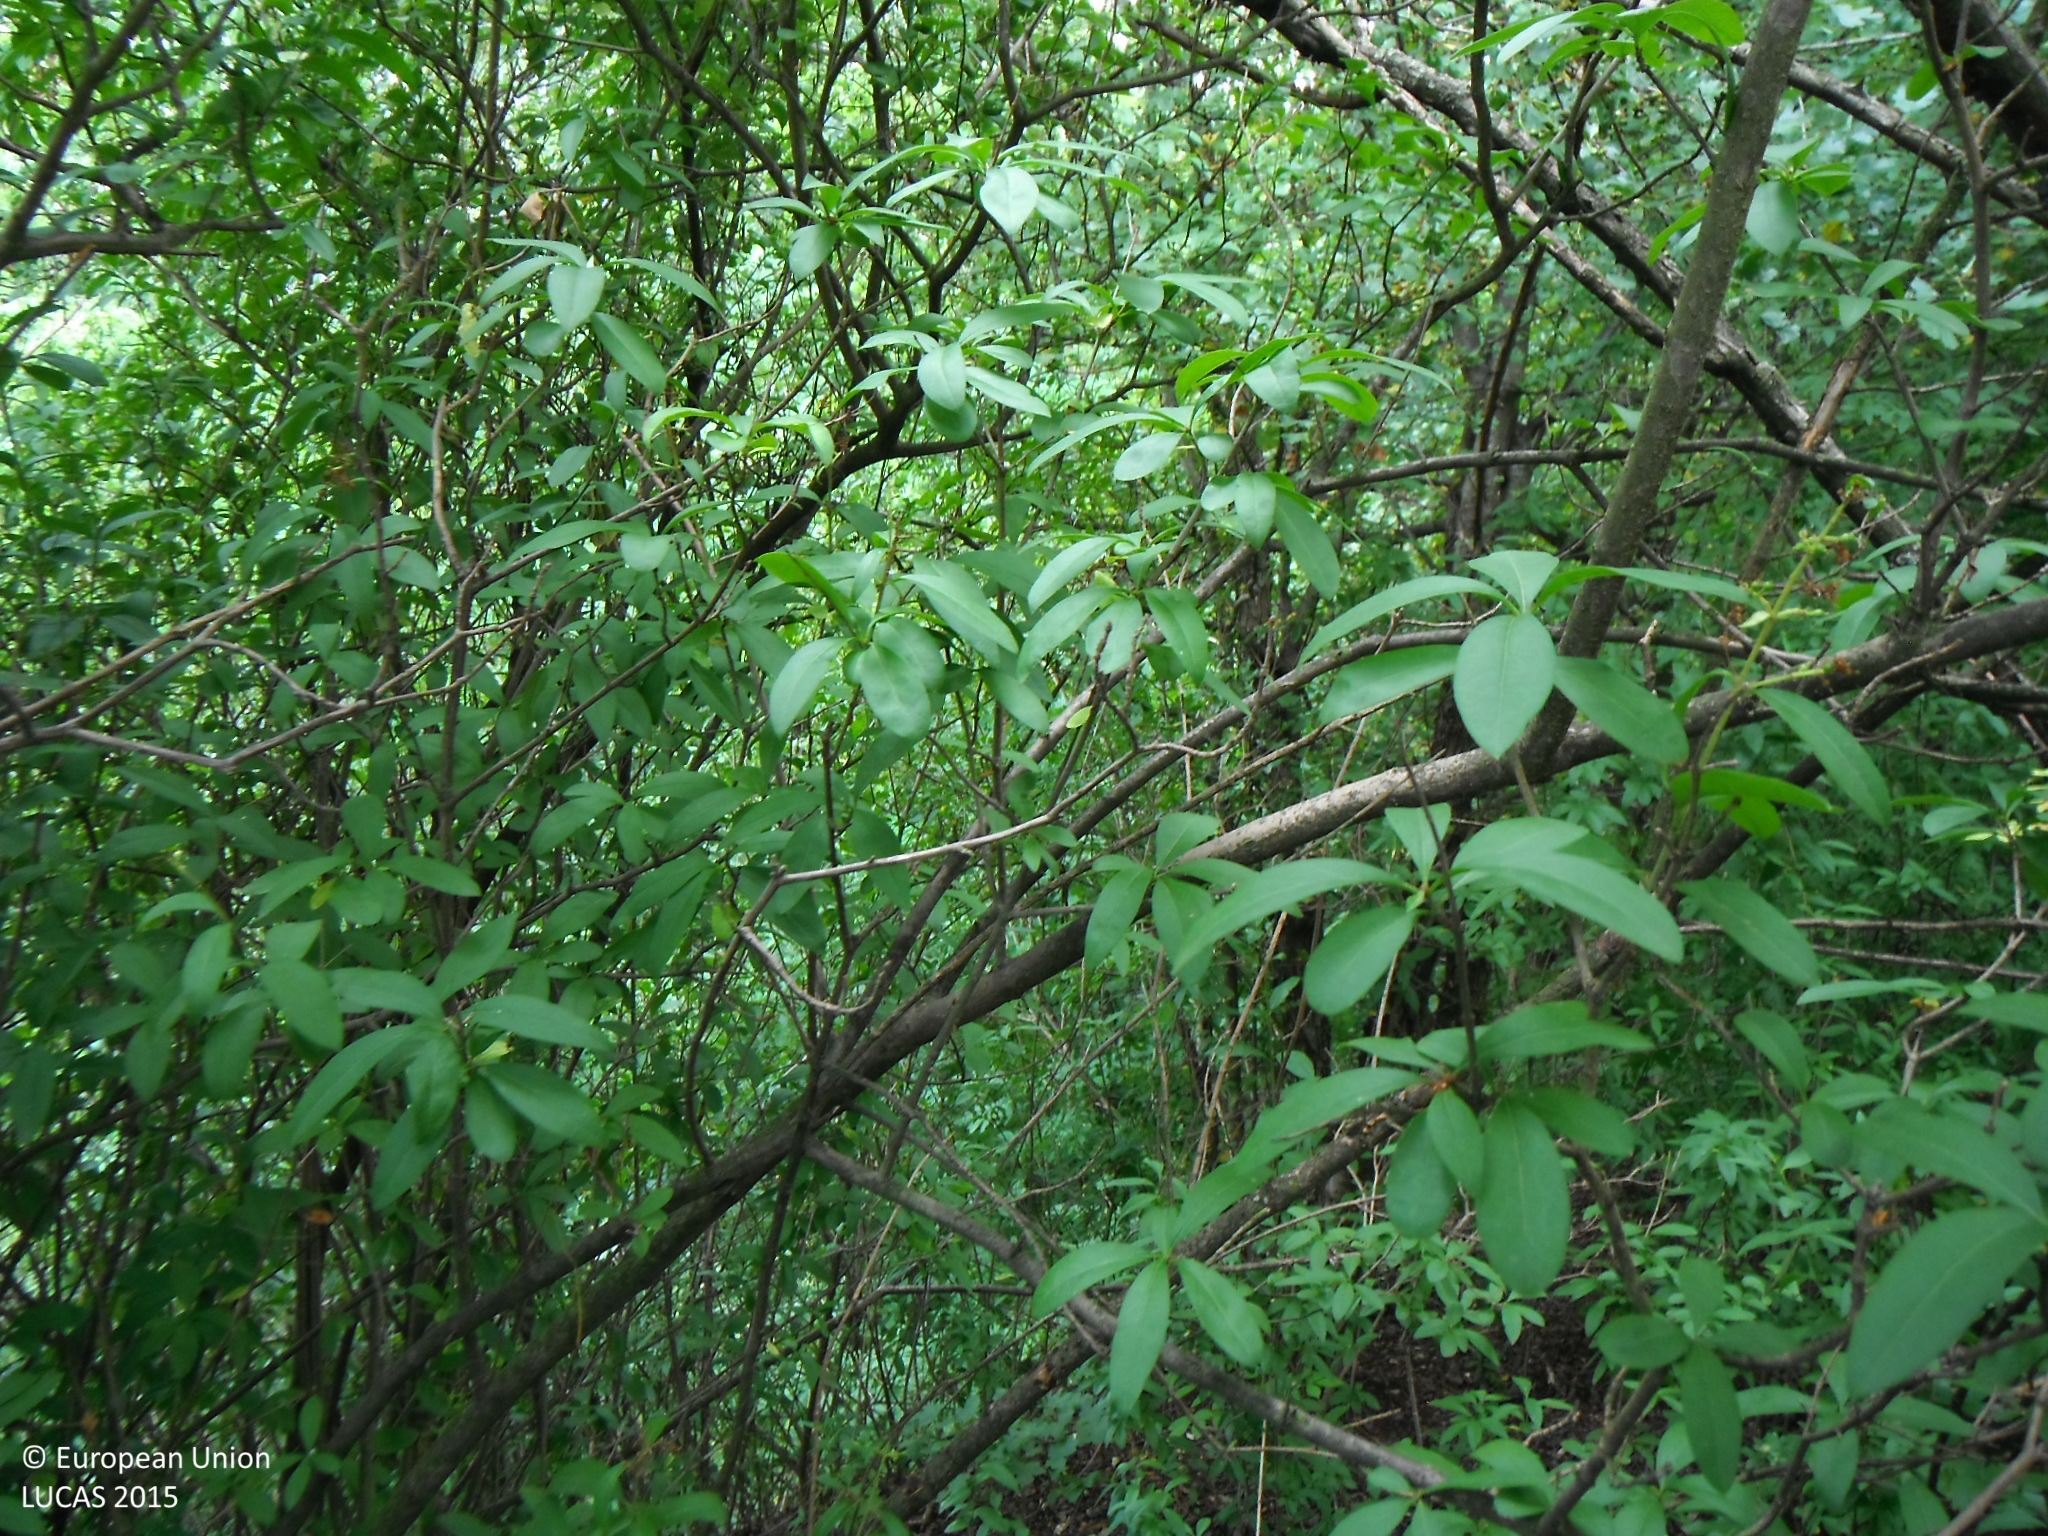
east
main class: Woodland
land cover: Broadleaved woodland
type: mesophytic deciduous forest
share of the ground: > 75 %
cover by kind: broadleaved forest trees 75 %, shrubs 25 %
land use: Semi-natural and natural areas not in use
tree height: > 5 m
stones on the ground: < 10 %
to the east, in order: Broadleaved woodland; Barley
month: July
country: SK
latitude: 48.7888
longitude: 21.4397
